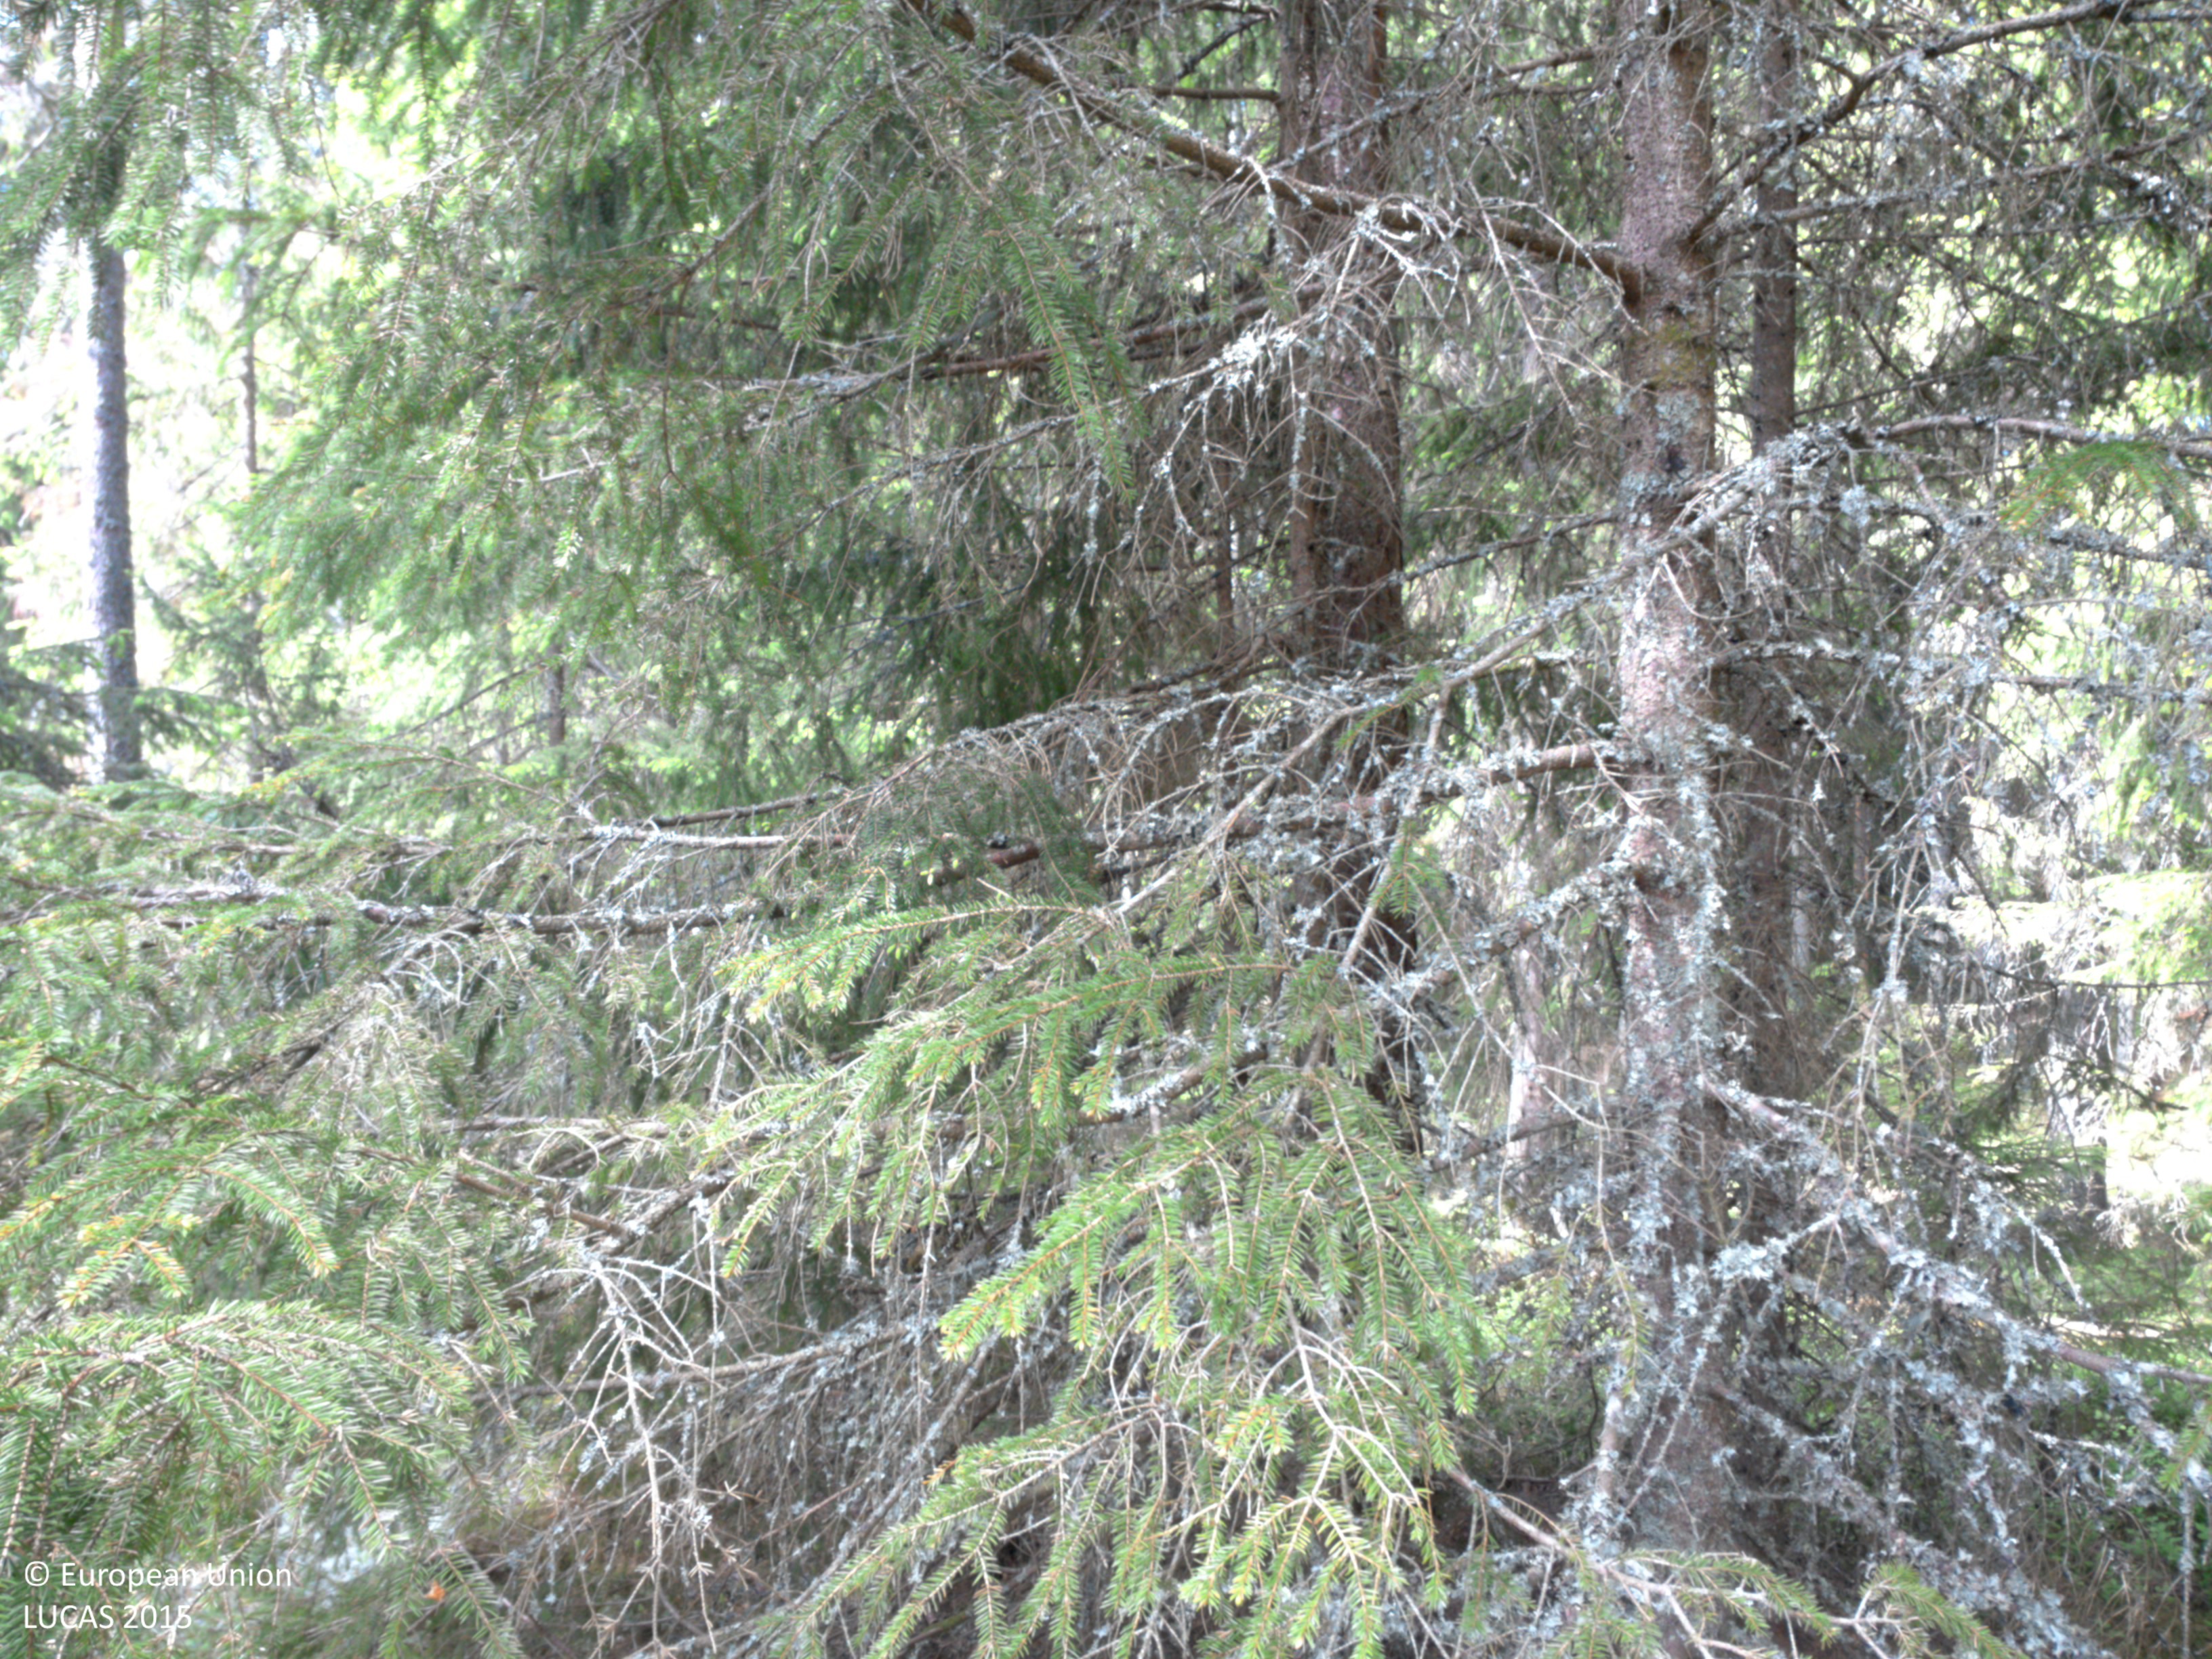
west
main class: Woodland
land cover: Spruce dominated coniferous woodland
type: boreal forest
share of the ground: 50 - 75 %
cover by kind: coniferous forest trees 55 %, lichens and mosses 30 %, herbaceous plants 10 %, shrubs 5 %
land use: Forestry
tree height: > 5 m
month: June
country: SE
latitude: 59.1707
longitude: 12.3561
